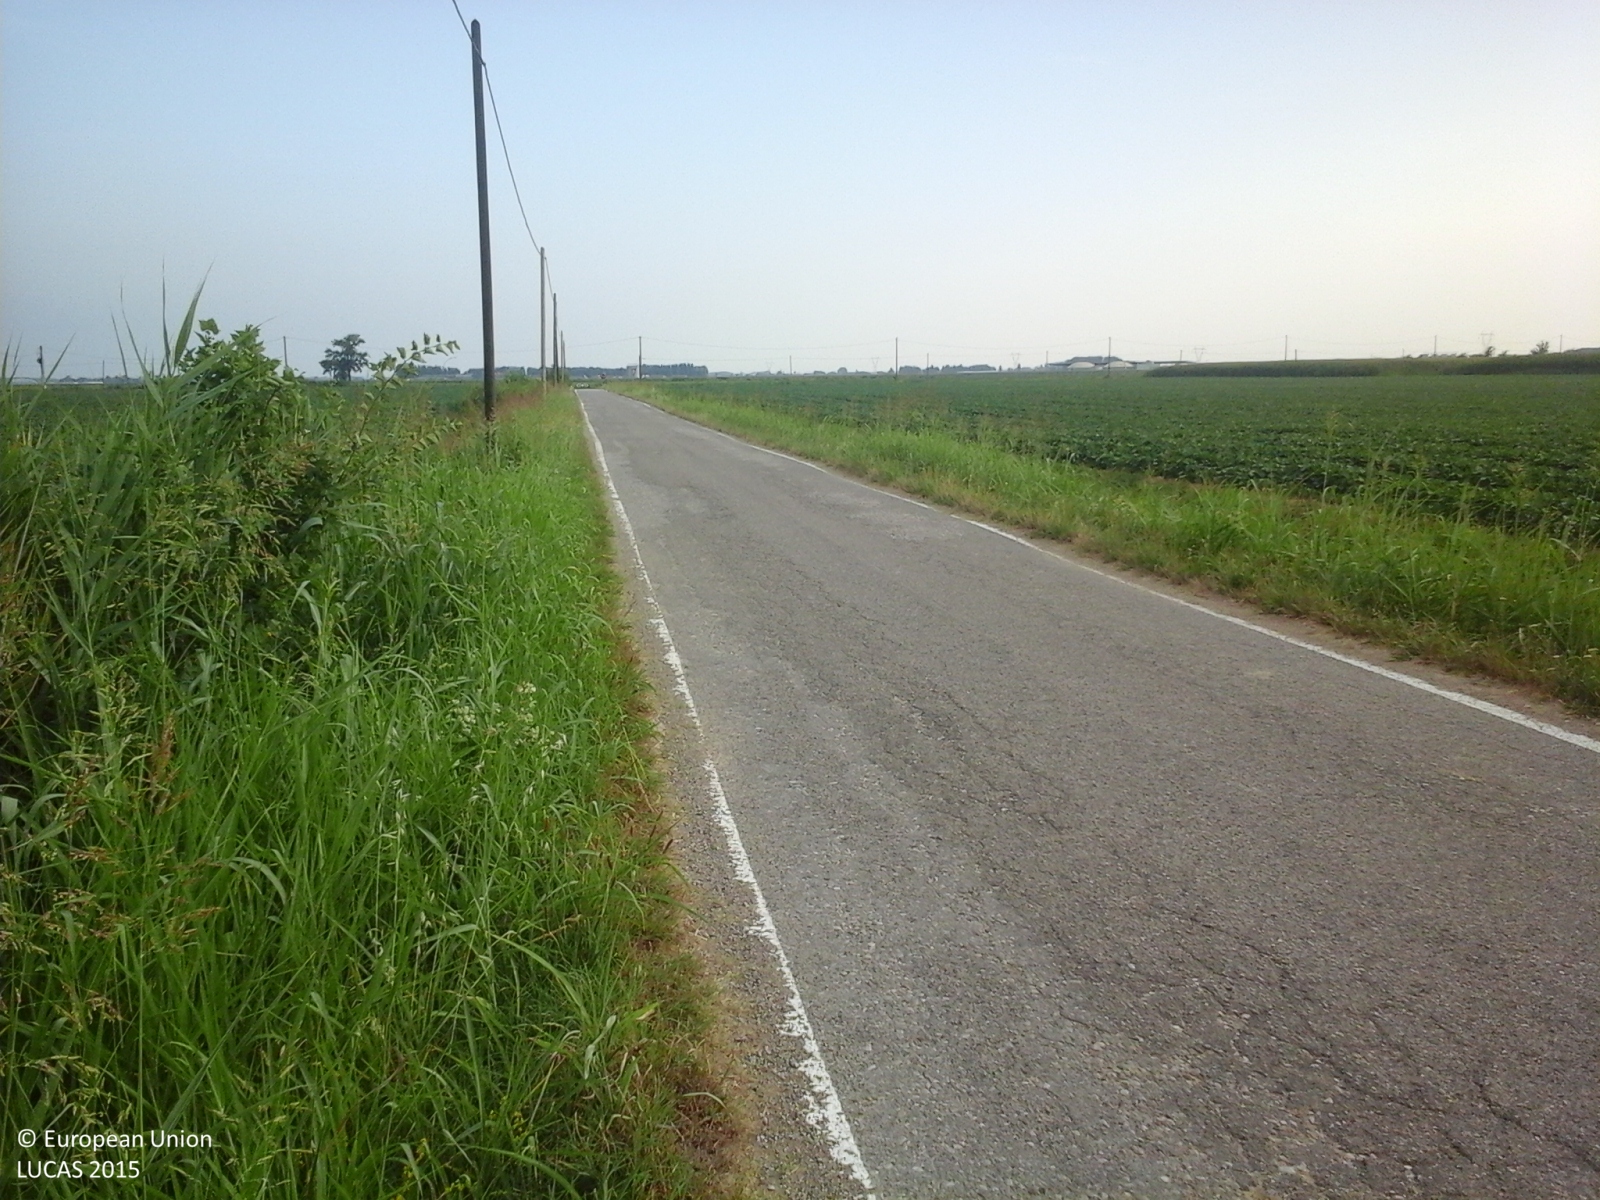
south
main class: Cropland
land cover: Soya
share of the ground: > 75 %
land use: Agriculture (excluding fallow land and kitchen gardens)
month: July
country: IT
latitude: 45.2484
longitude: 10.8775
